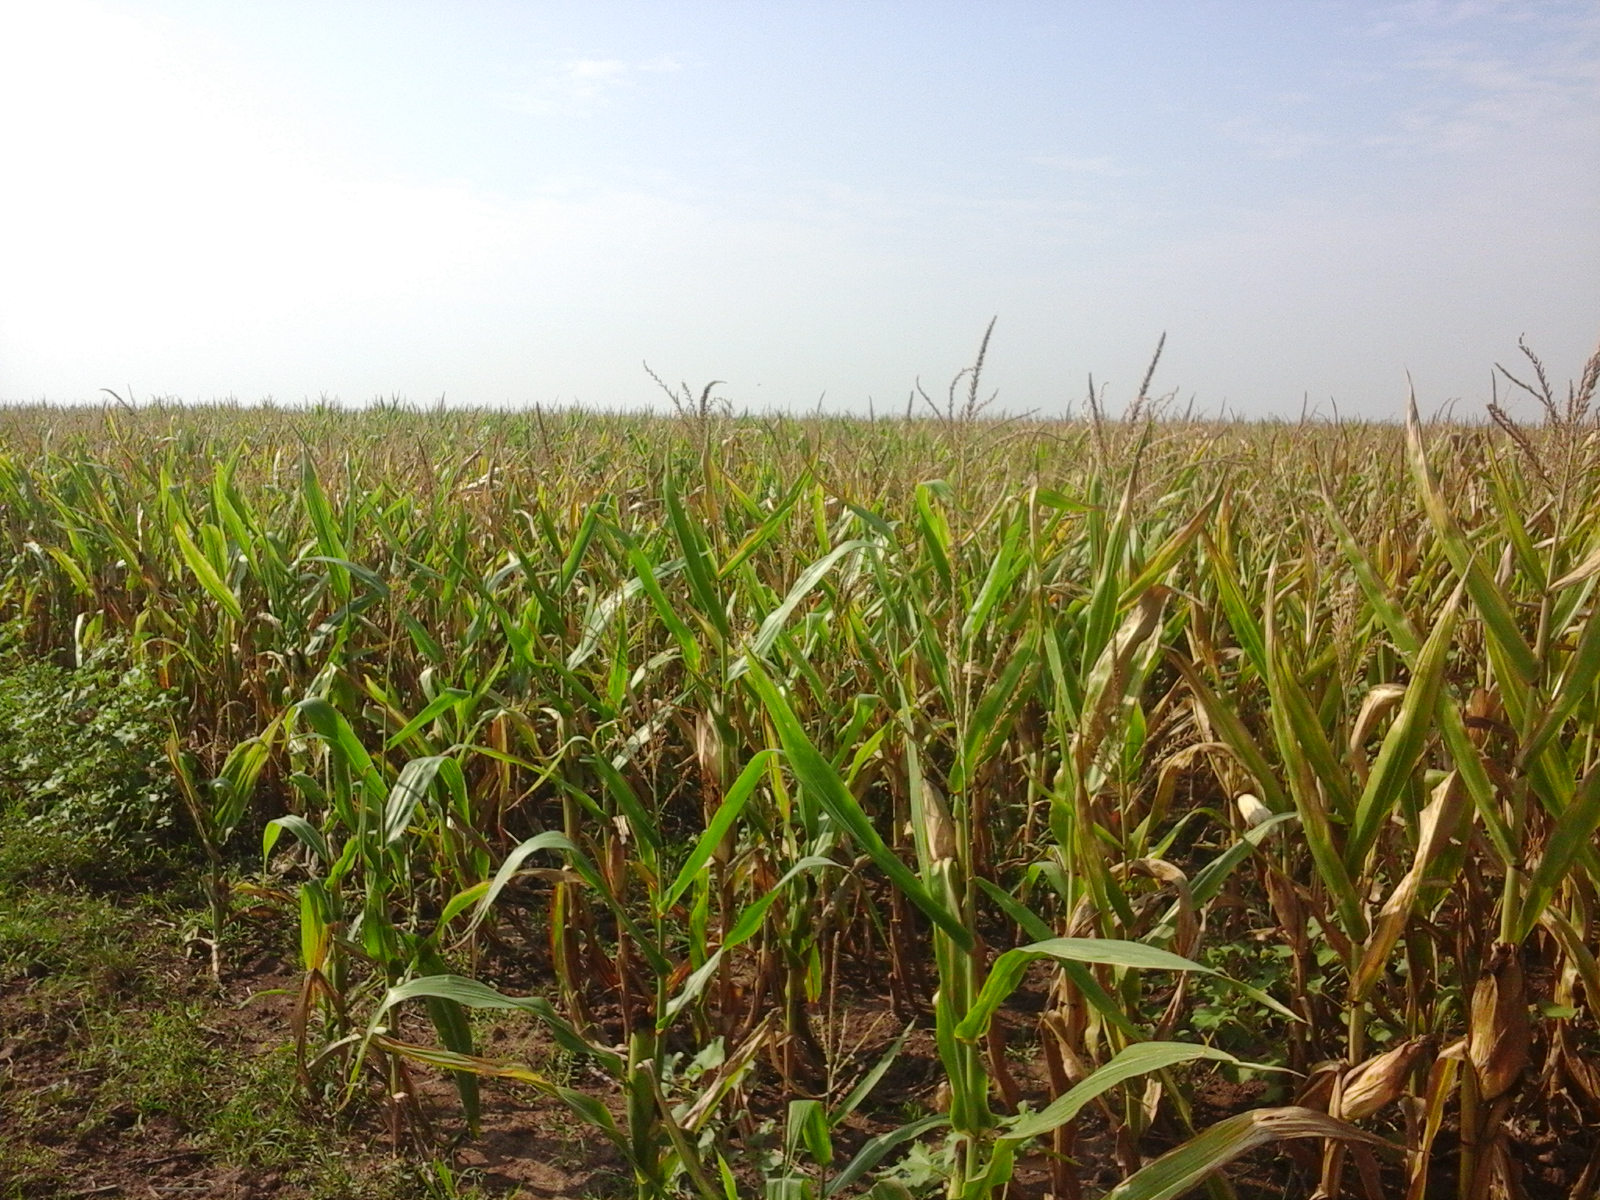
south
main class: Cropland
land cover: Maize
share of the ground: > 75 %
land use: Agriculture (excluding fallow land and kitchen gardens)
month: August
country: RO
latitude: 46.5413
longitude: 21.5531
